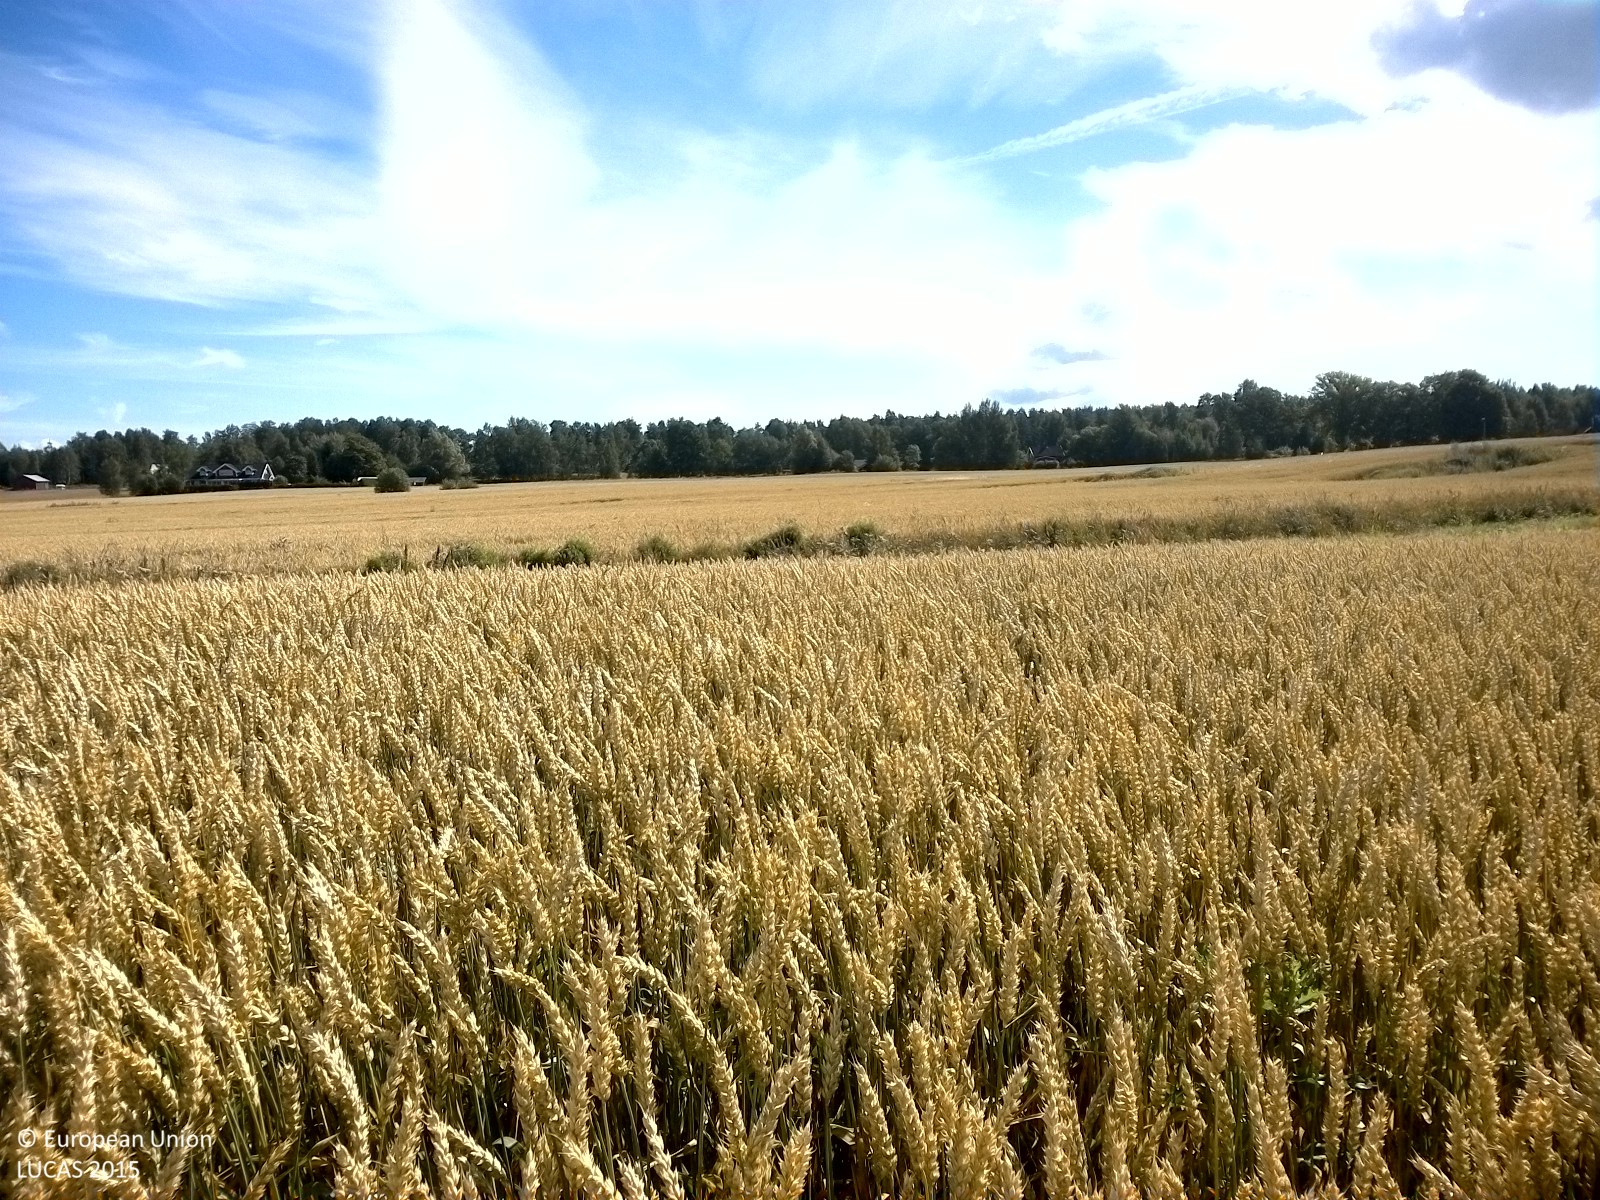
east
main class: Cropland
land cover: Common wheat
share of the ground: > 75 %
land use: Agriculture (excluding fallow land and kitchen gardens)
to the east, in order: Common wheat; Grass margins; Paved roads, cycling and walking lanes; Grass margins; Ditches and canals; Common wheat
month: August
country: SE
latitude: 59.0590
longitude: 15.1362
